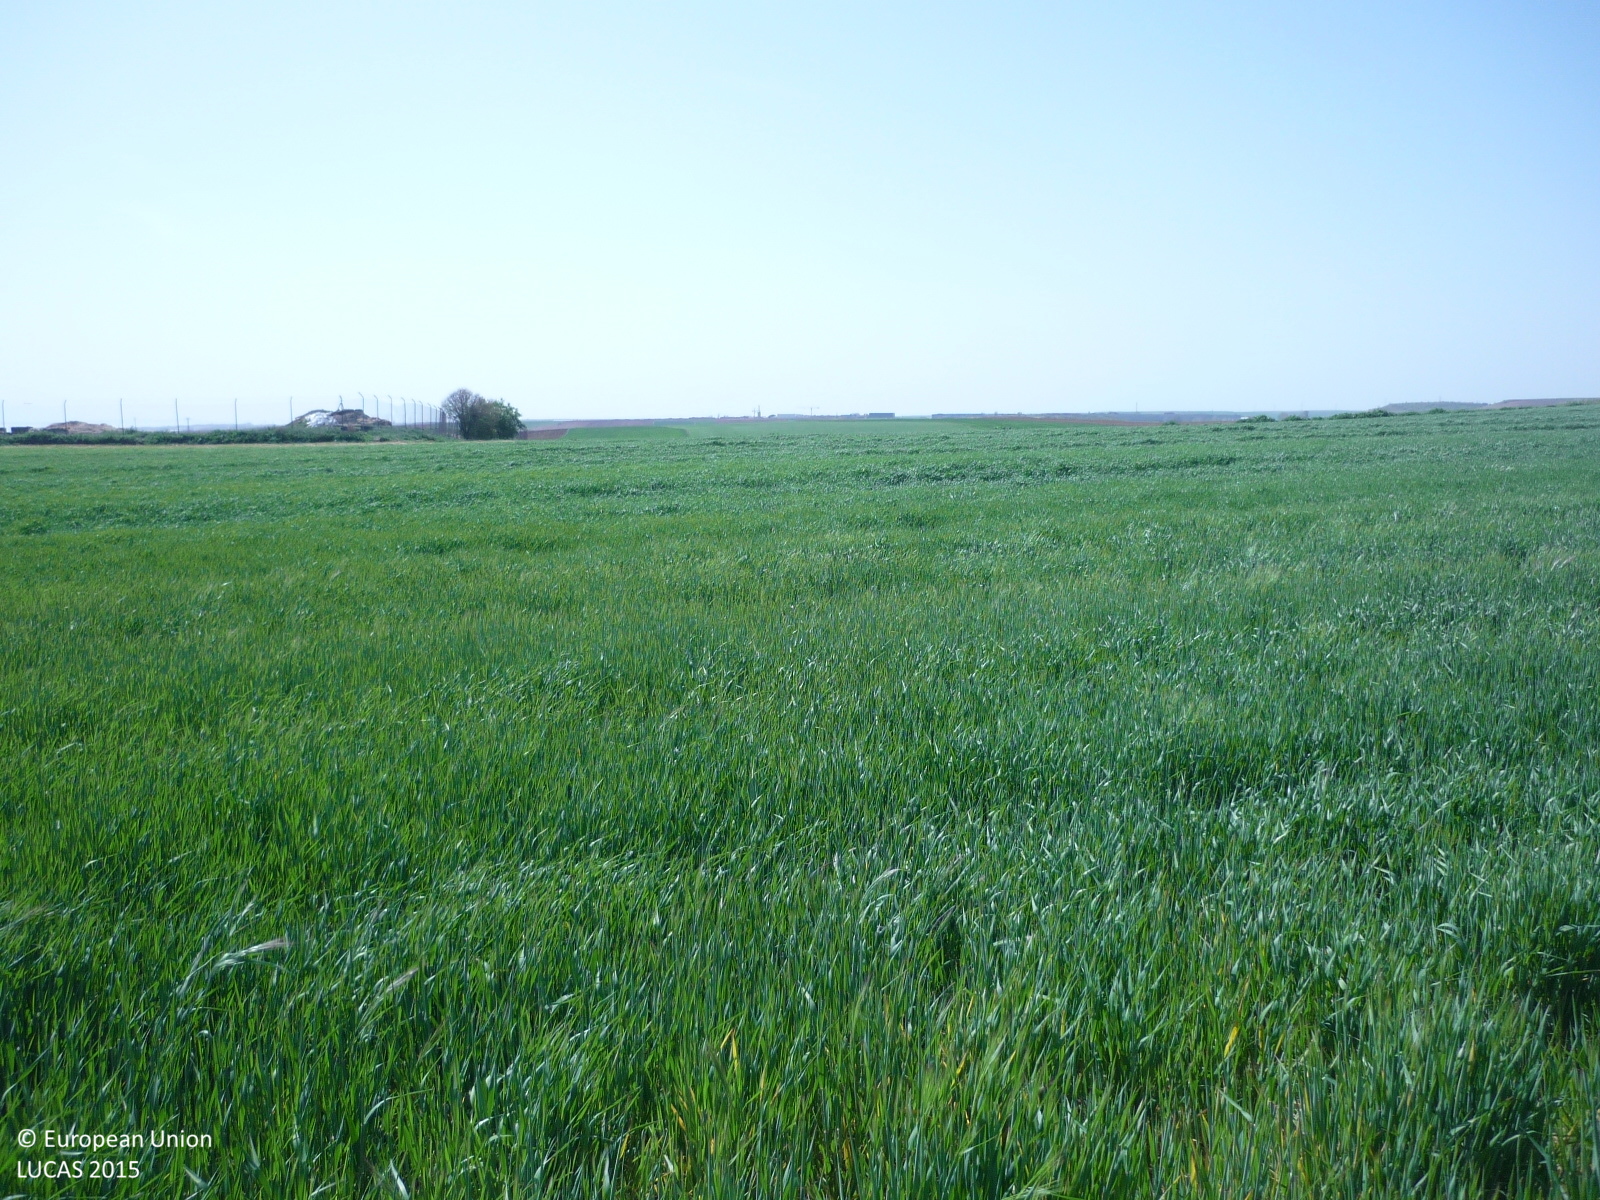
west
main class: Cropland
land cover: Barley
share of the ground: > 75 %
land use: Agriculture (excluding fallow land and kitchen gardens)
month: April
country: ES
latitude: 40.5321
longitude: -3.4107
